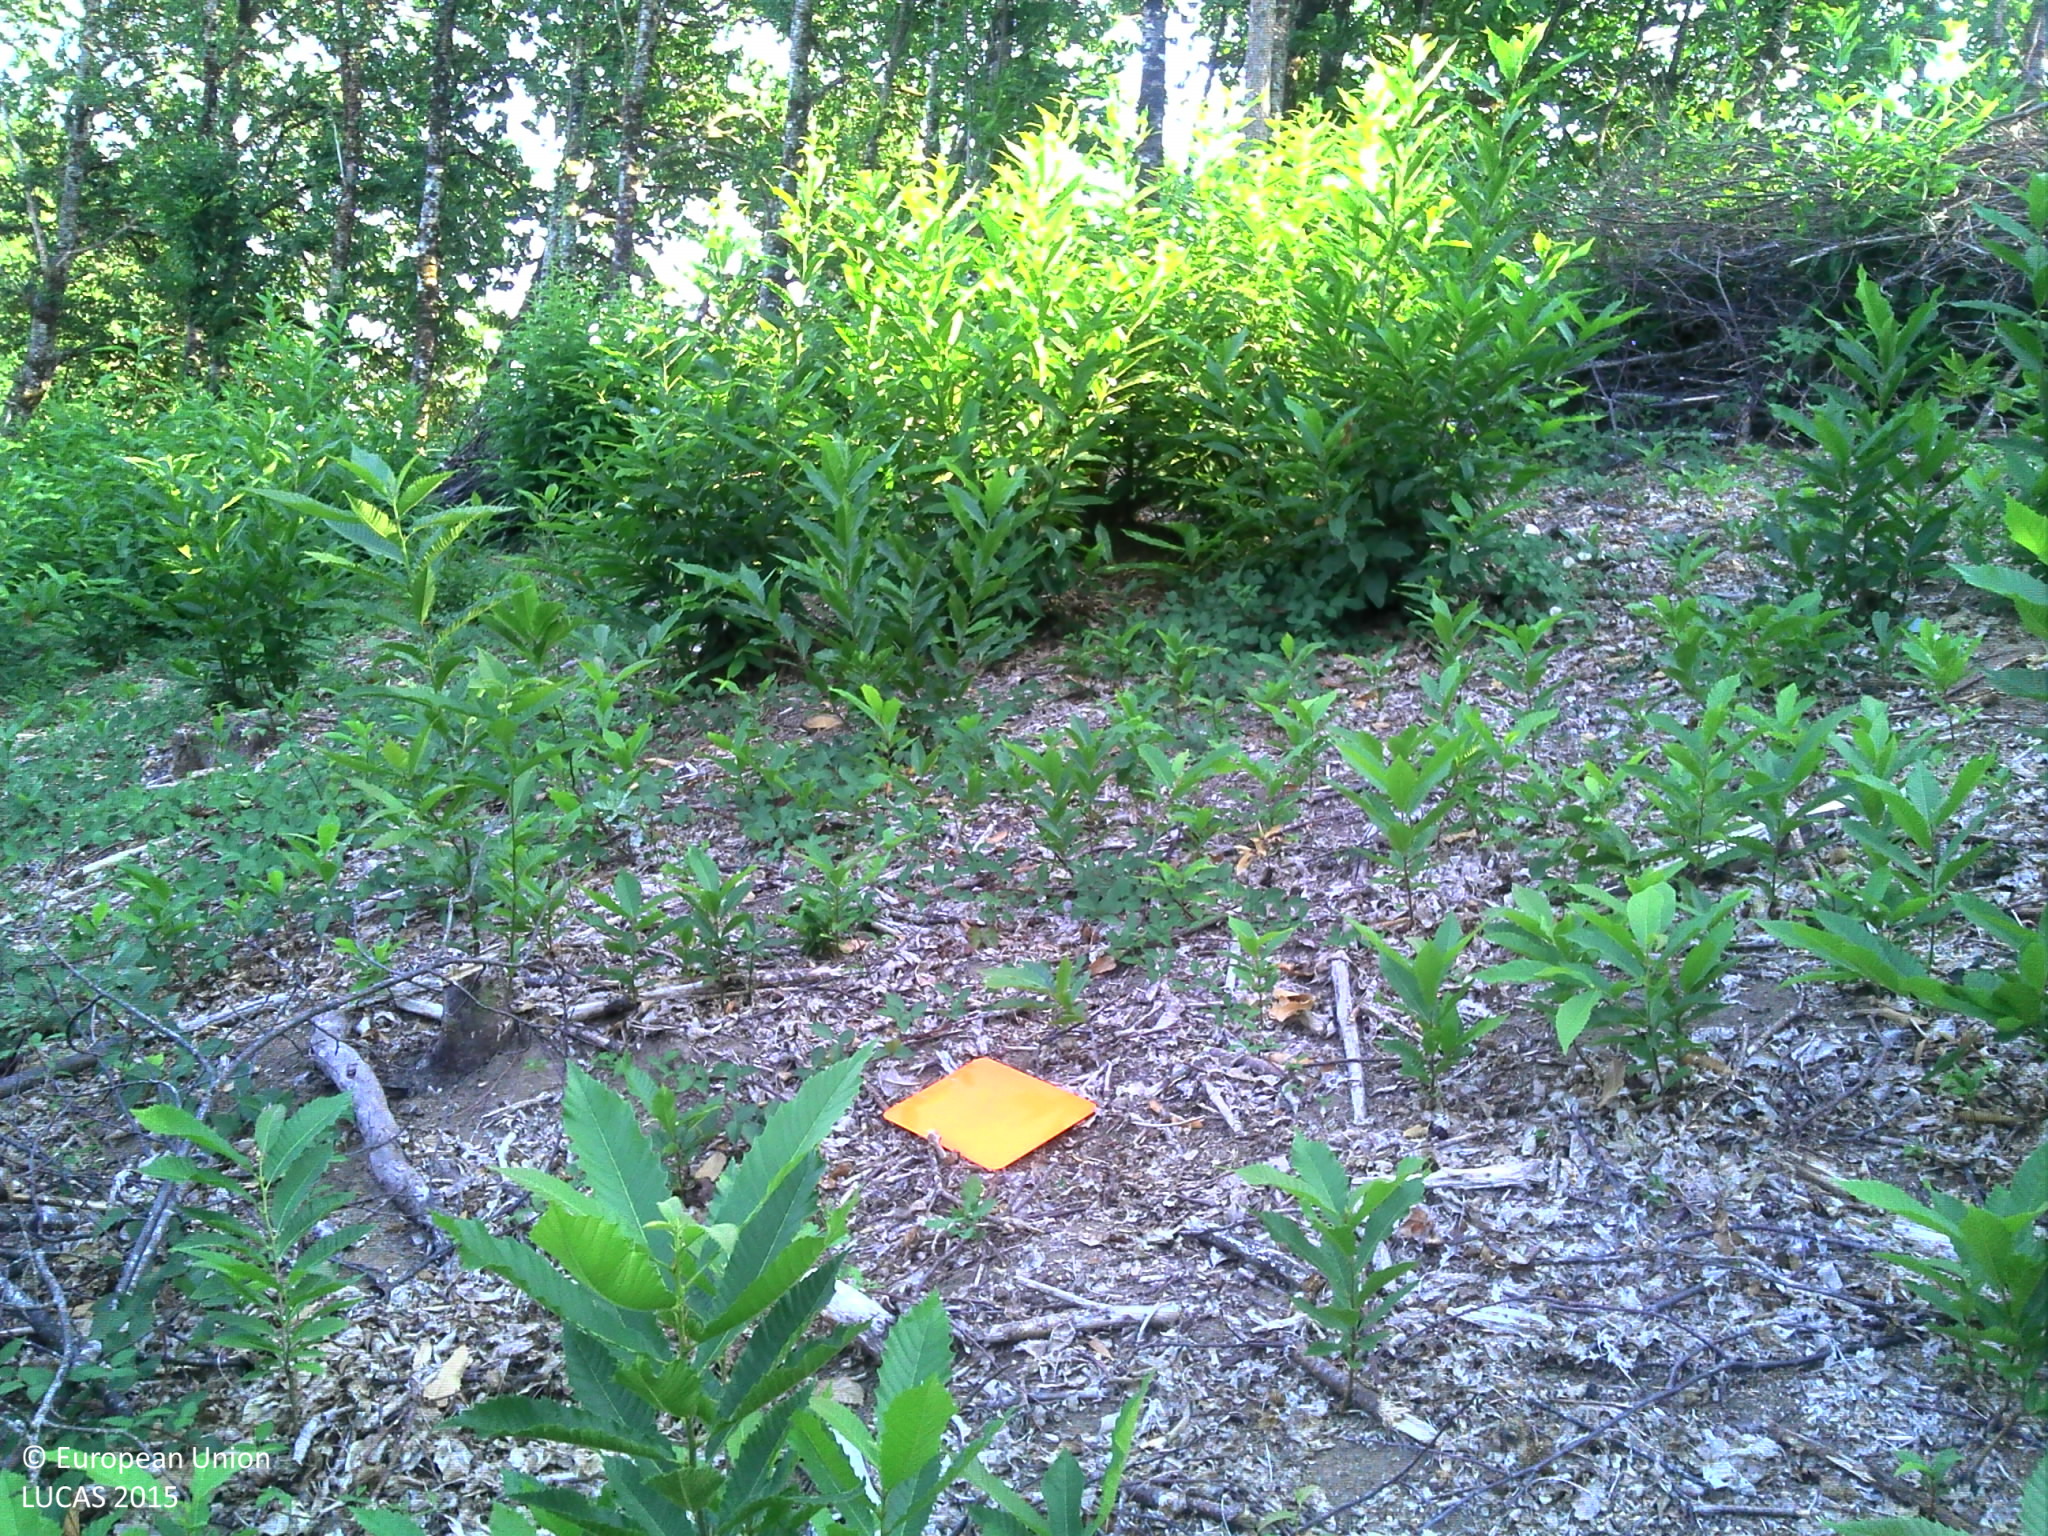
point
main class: Woodland
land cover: Broadleaved woodland
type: thermophilous deciduous forest
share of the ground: 50 - 75 %
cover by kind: broadleaved forest trees 50 %, unconsolidated bare surface 50 %
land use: Forestry
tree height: > 5 m
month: August
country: FR
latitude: 45.3034
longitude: 1.6931
